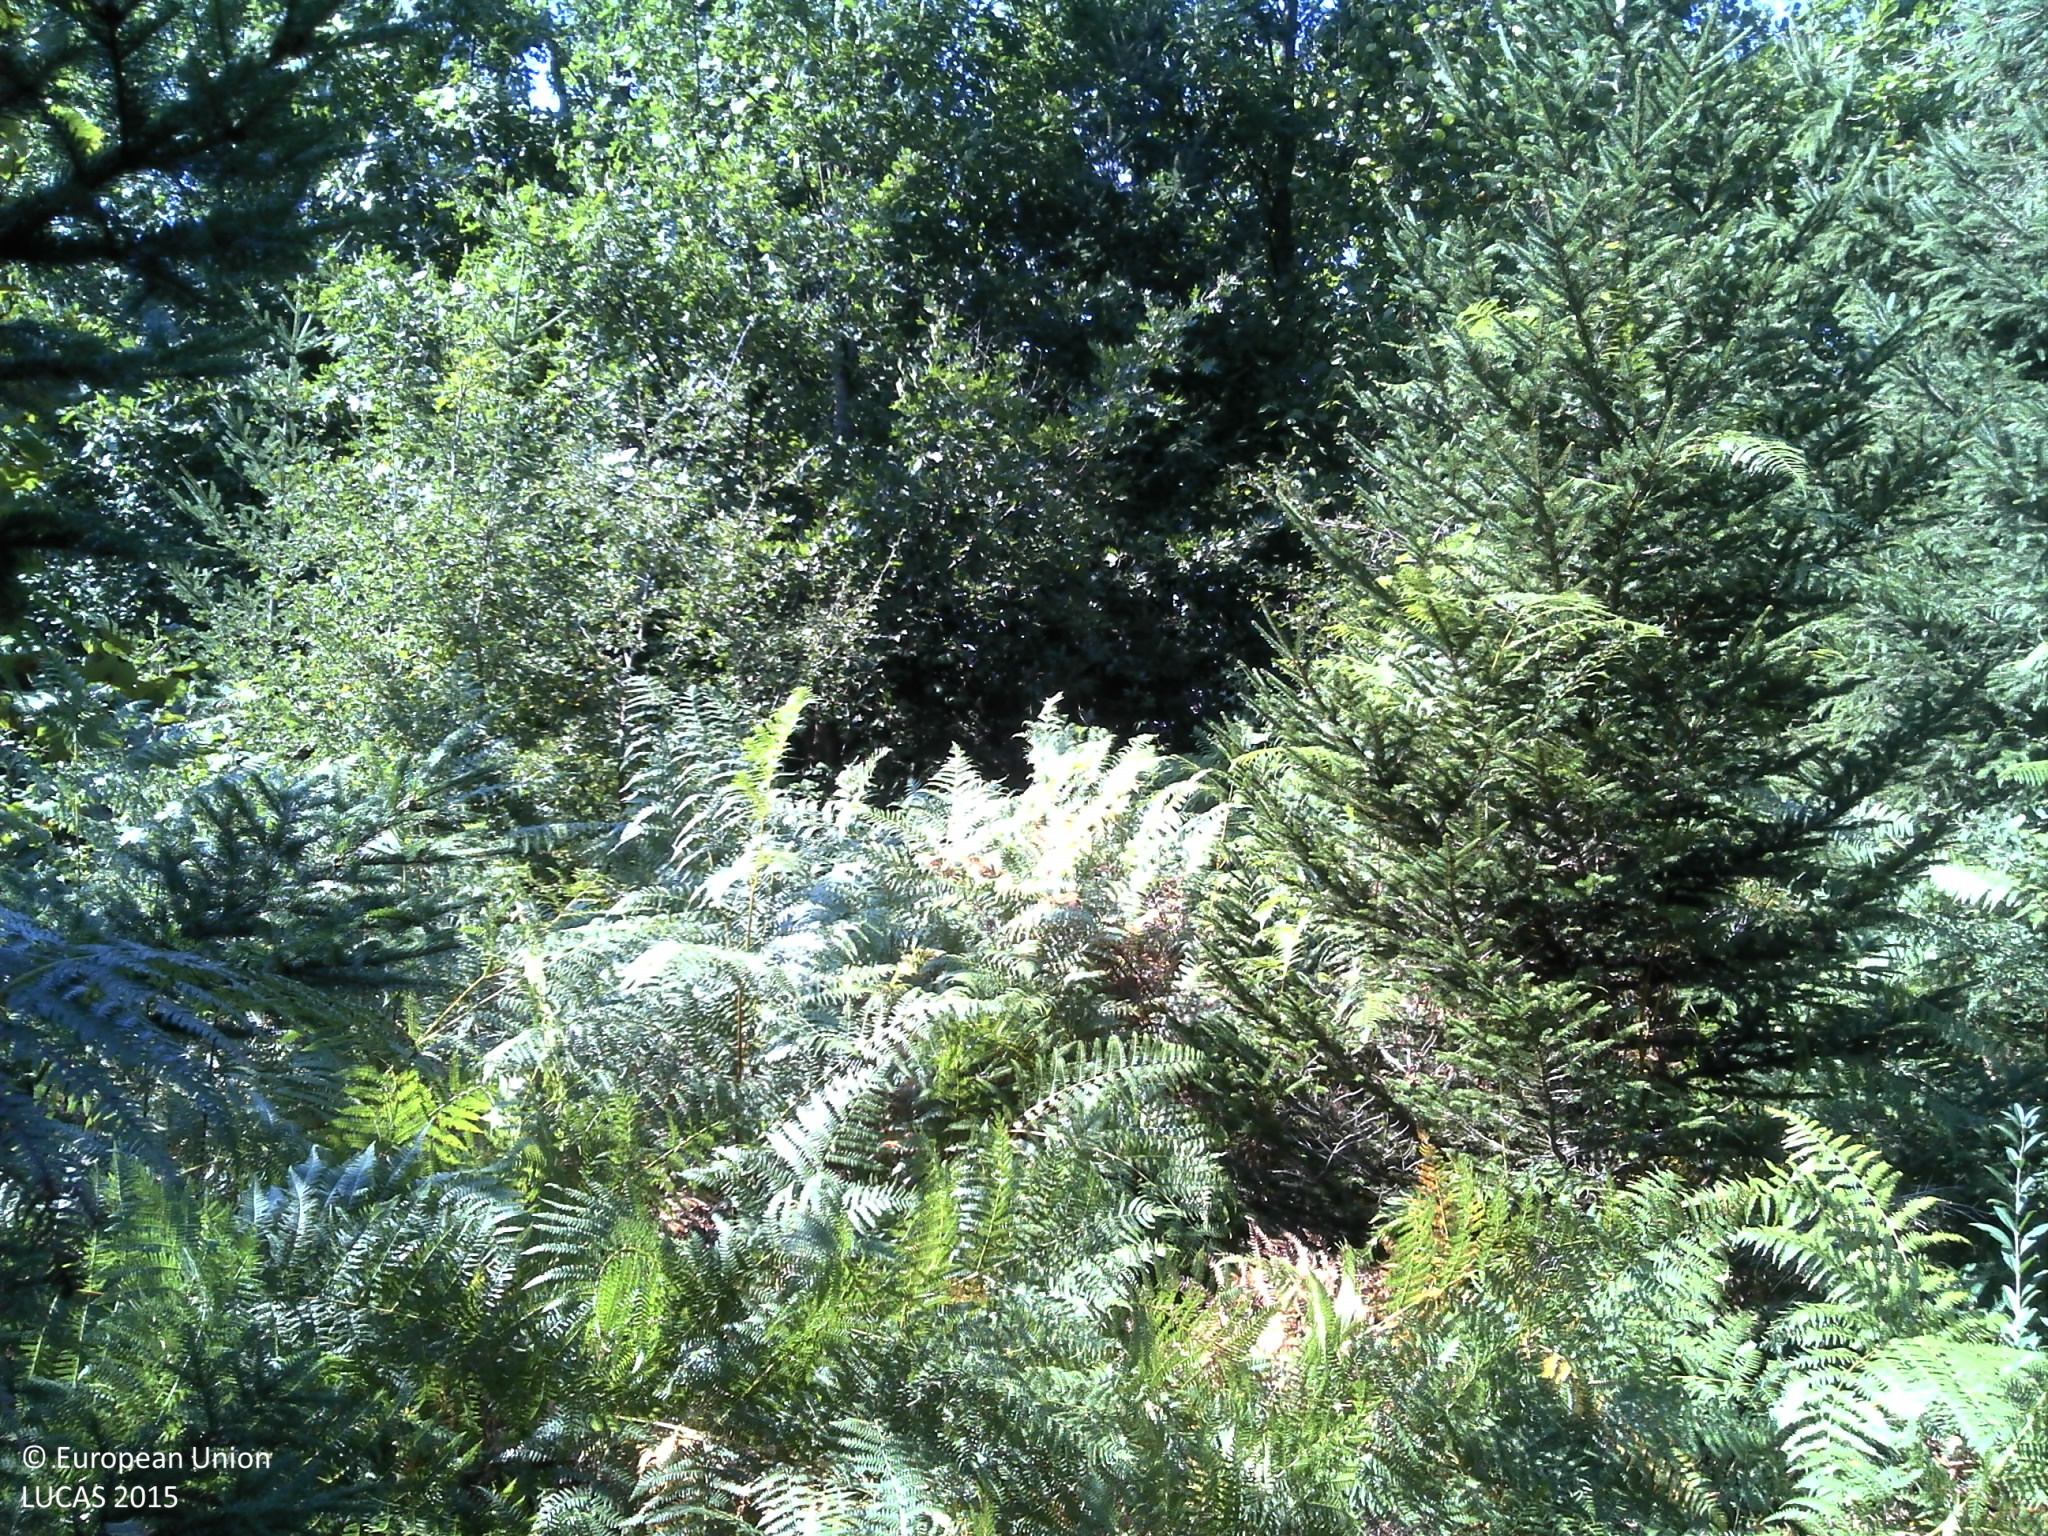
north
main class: Woodland
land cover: Spruce dominated coniferous woodland
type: coniferous forest of the mediterranean region
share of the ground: > 75 %
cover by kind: coniferous forest trees 100 %
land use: Forestry
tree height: > 5 m
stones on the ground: < 10 %
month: September
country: HR
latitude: 45.3177
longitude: 15.2894
